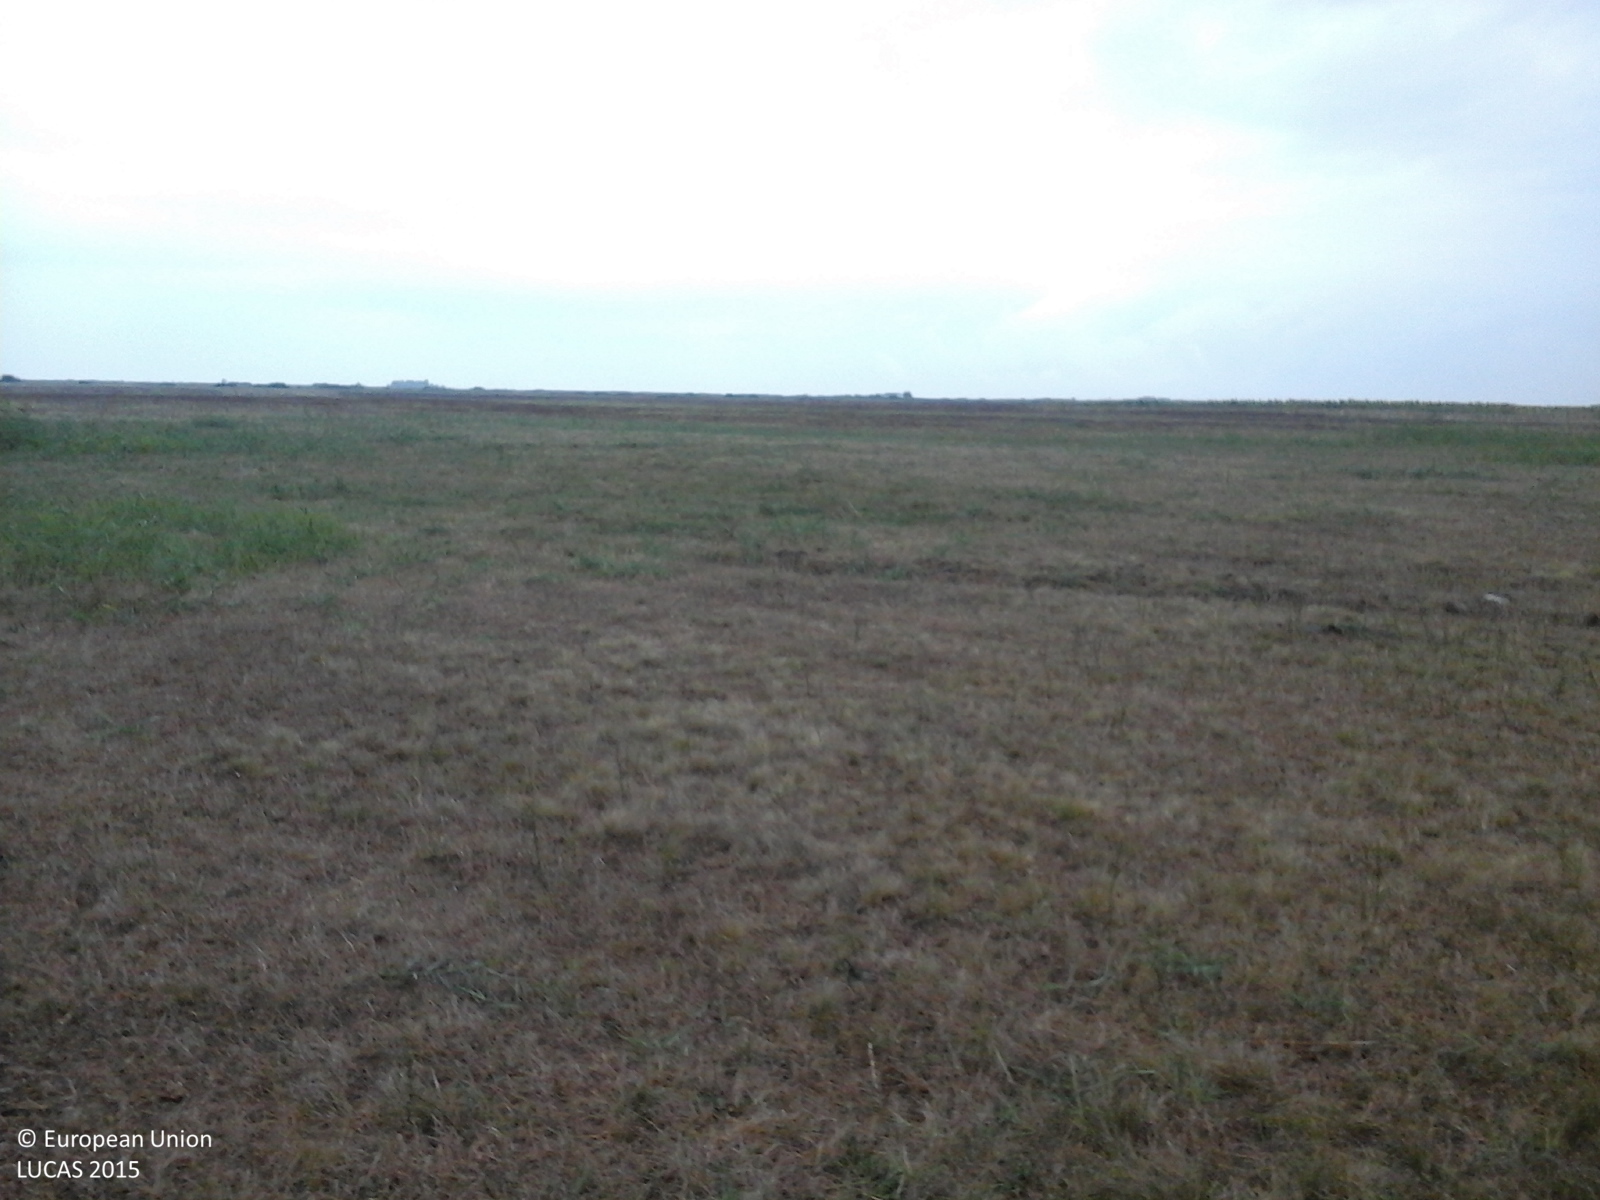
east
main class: Grassland
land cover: Grassland without tree/shrub cover
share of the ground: > 75 %
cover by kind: herbaceous plants 100 %
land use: Agriculture (excluding fallow land and kitchen gardens)
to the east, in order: Grassland without tree/shrub cover
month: August
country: RO
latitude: 45.6727
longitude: 21.0032
